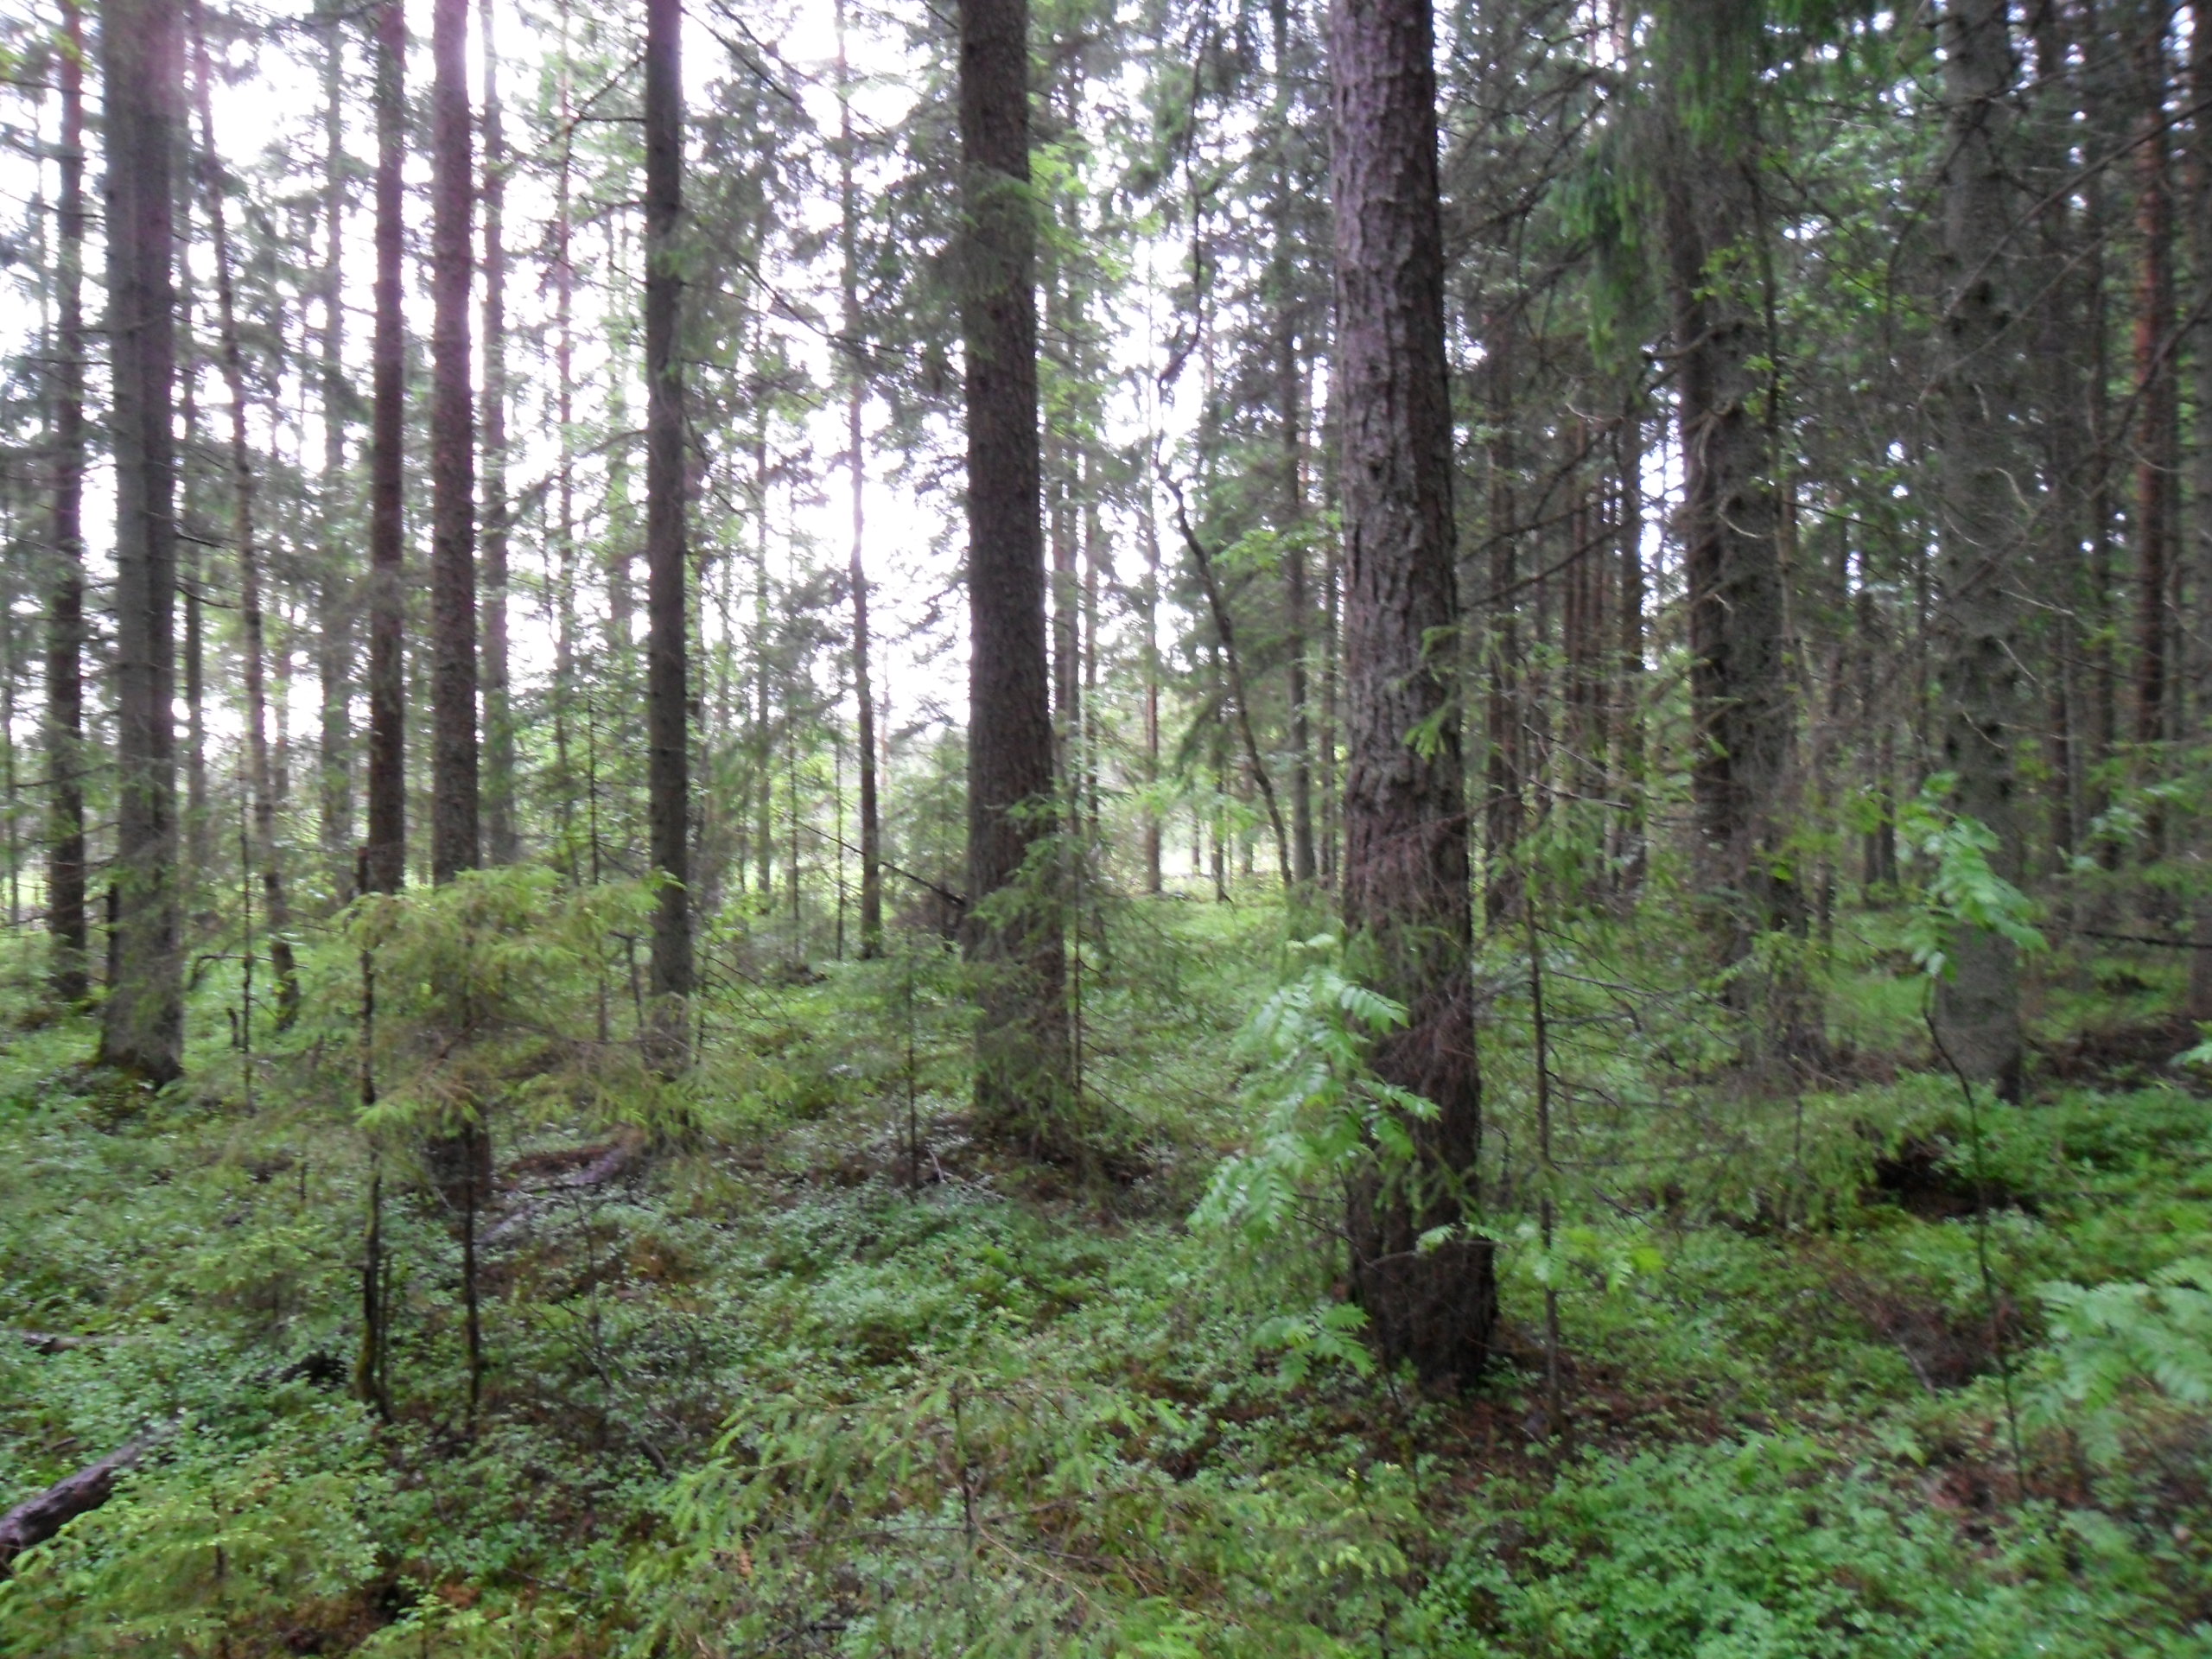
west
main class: Woodland
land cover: Other coniferous woodland
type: hemiboreal forest and nemoral coniferous forest and mixed broadleaved-coniferous forest
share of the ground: 50 - 75 %
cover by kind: coniferous forest trees 70 %, herbaceous plants 30 %
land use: Forestry
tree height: > 5 m
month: June
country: LV
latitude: 57.4555
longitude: 21.8601
